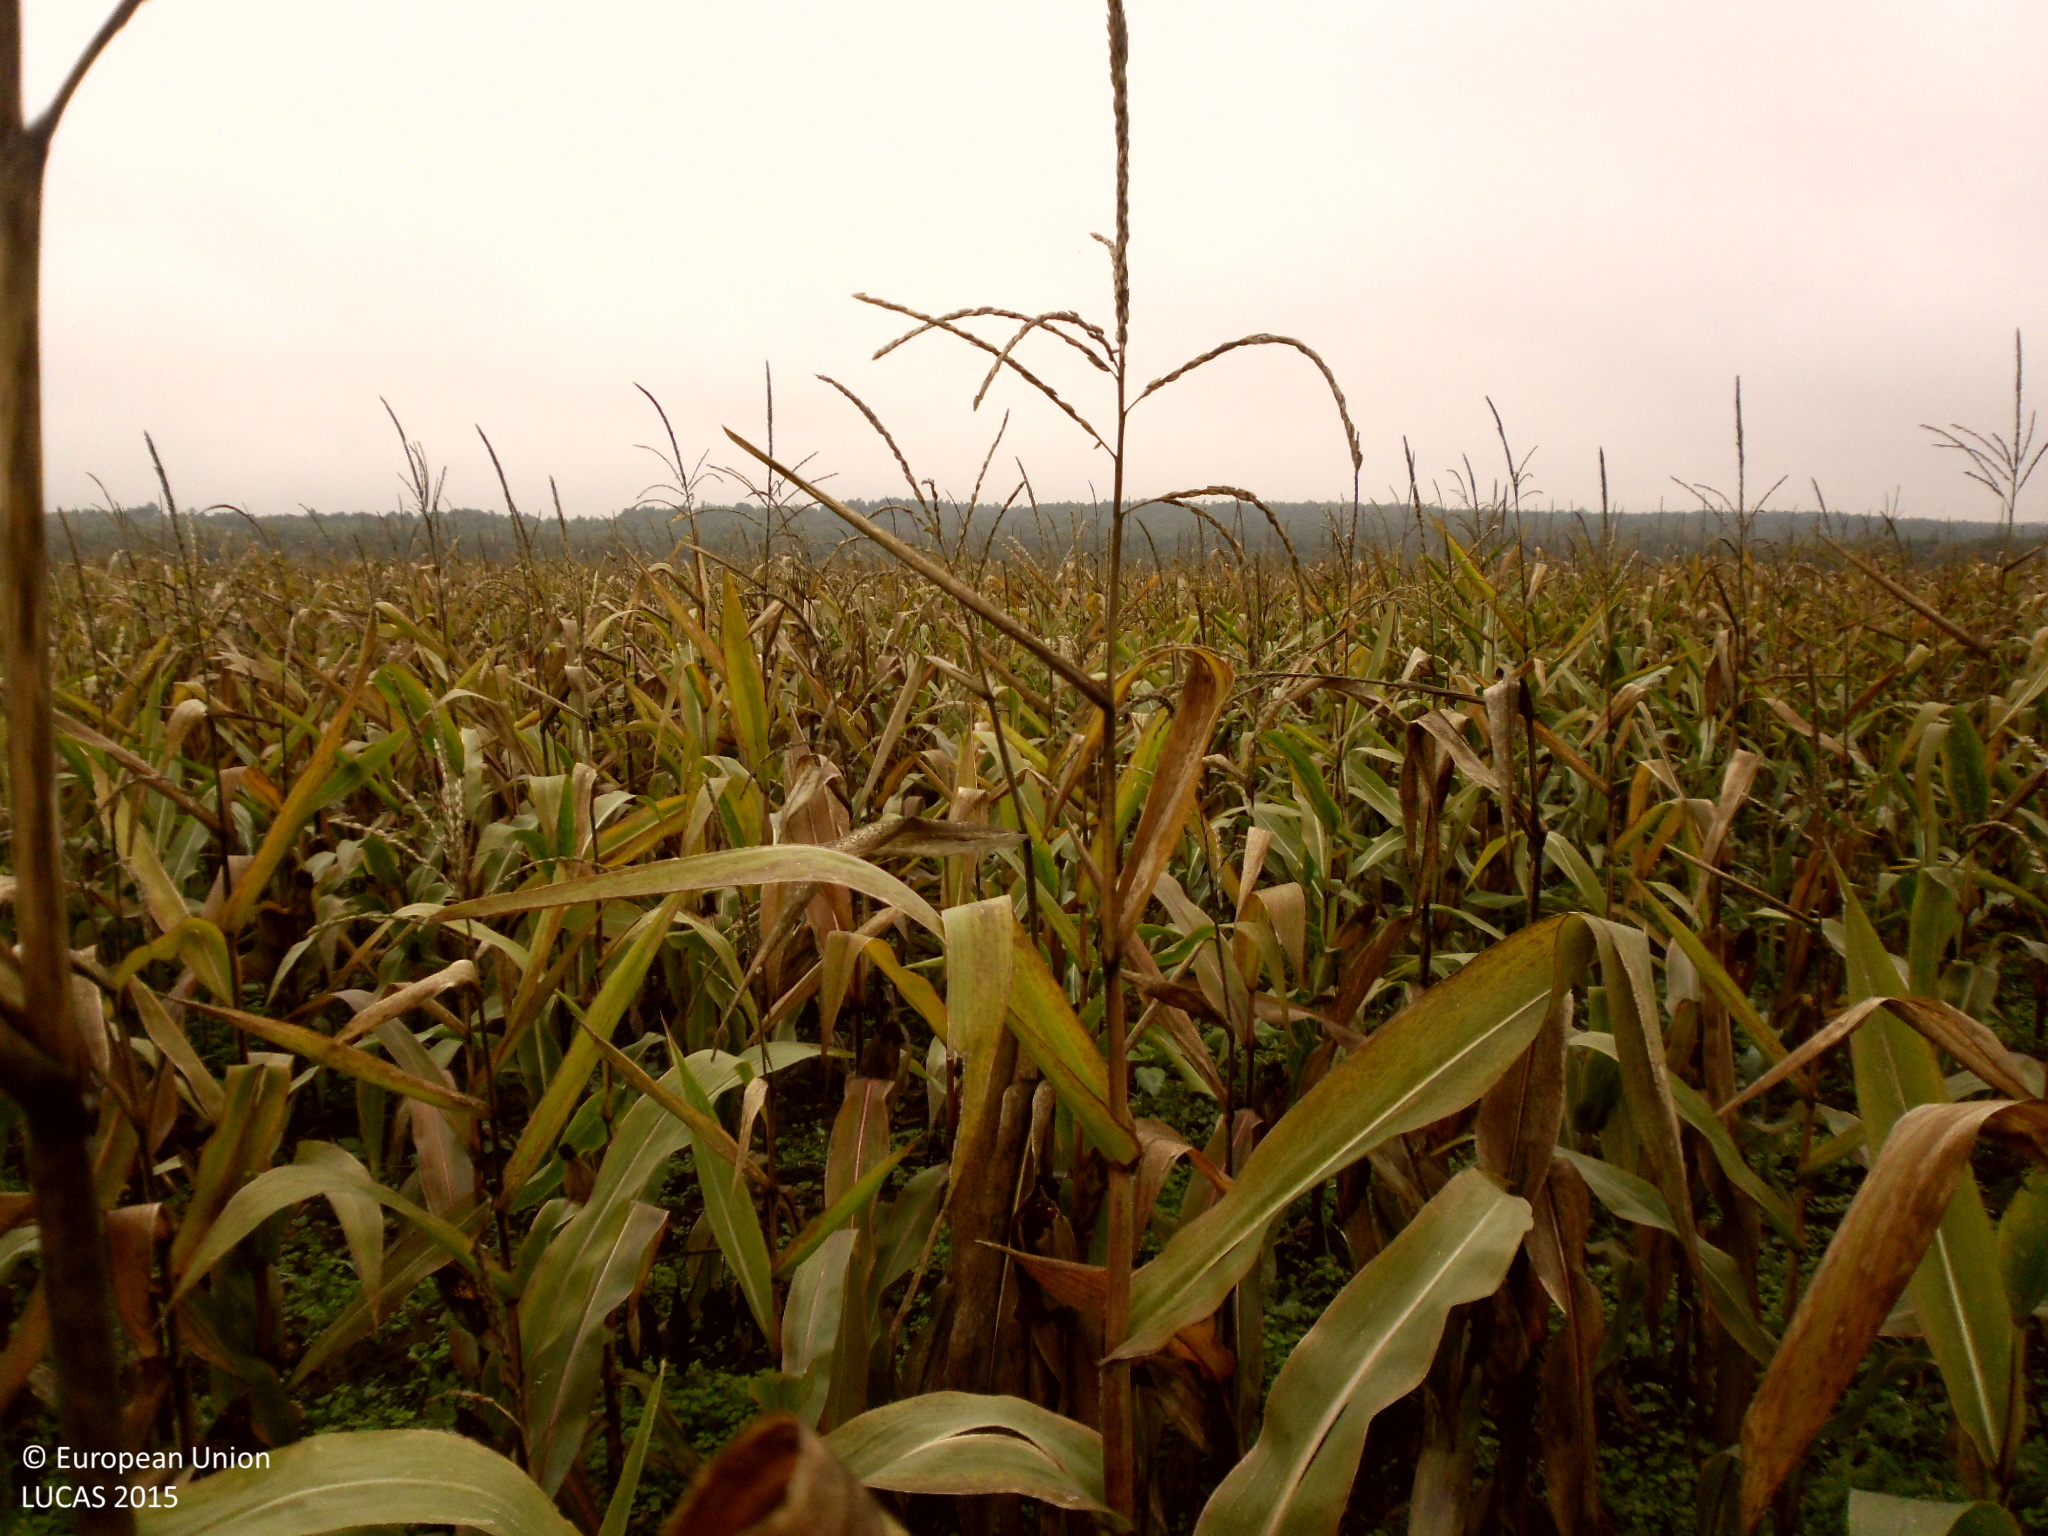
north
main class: Cropland
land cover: Maize
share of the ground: > 75 %
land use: Agriculture (excluding fallow land and kitchen gardens)
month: October
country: BG
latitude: 43.9755
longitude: 22.6390
